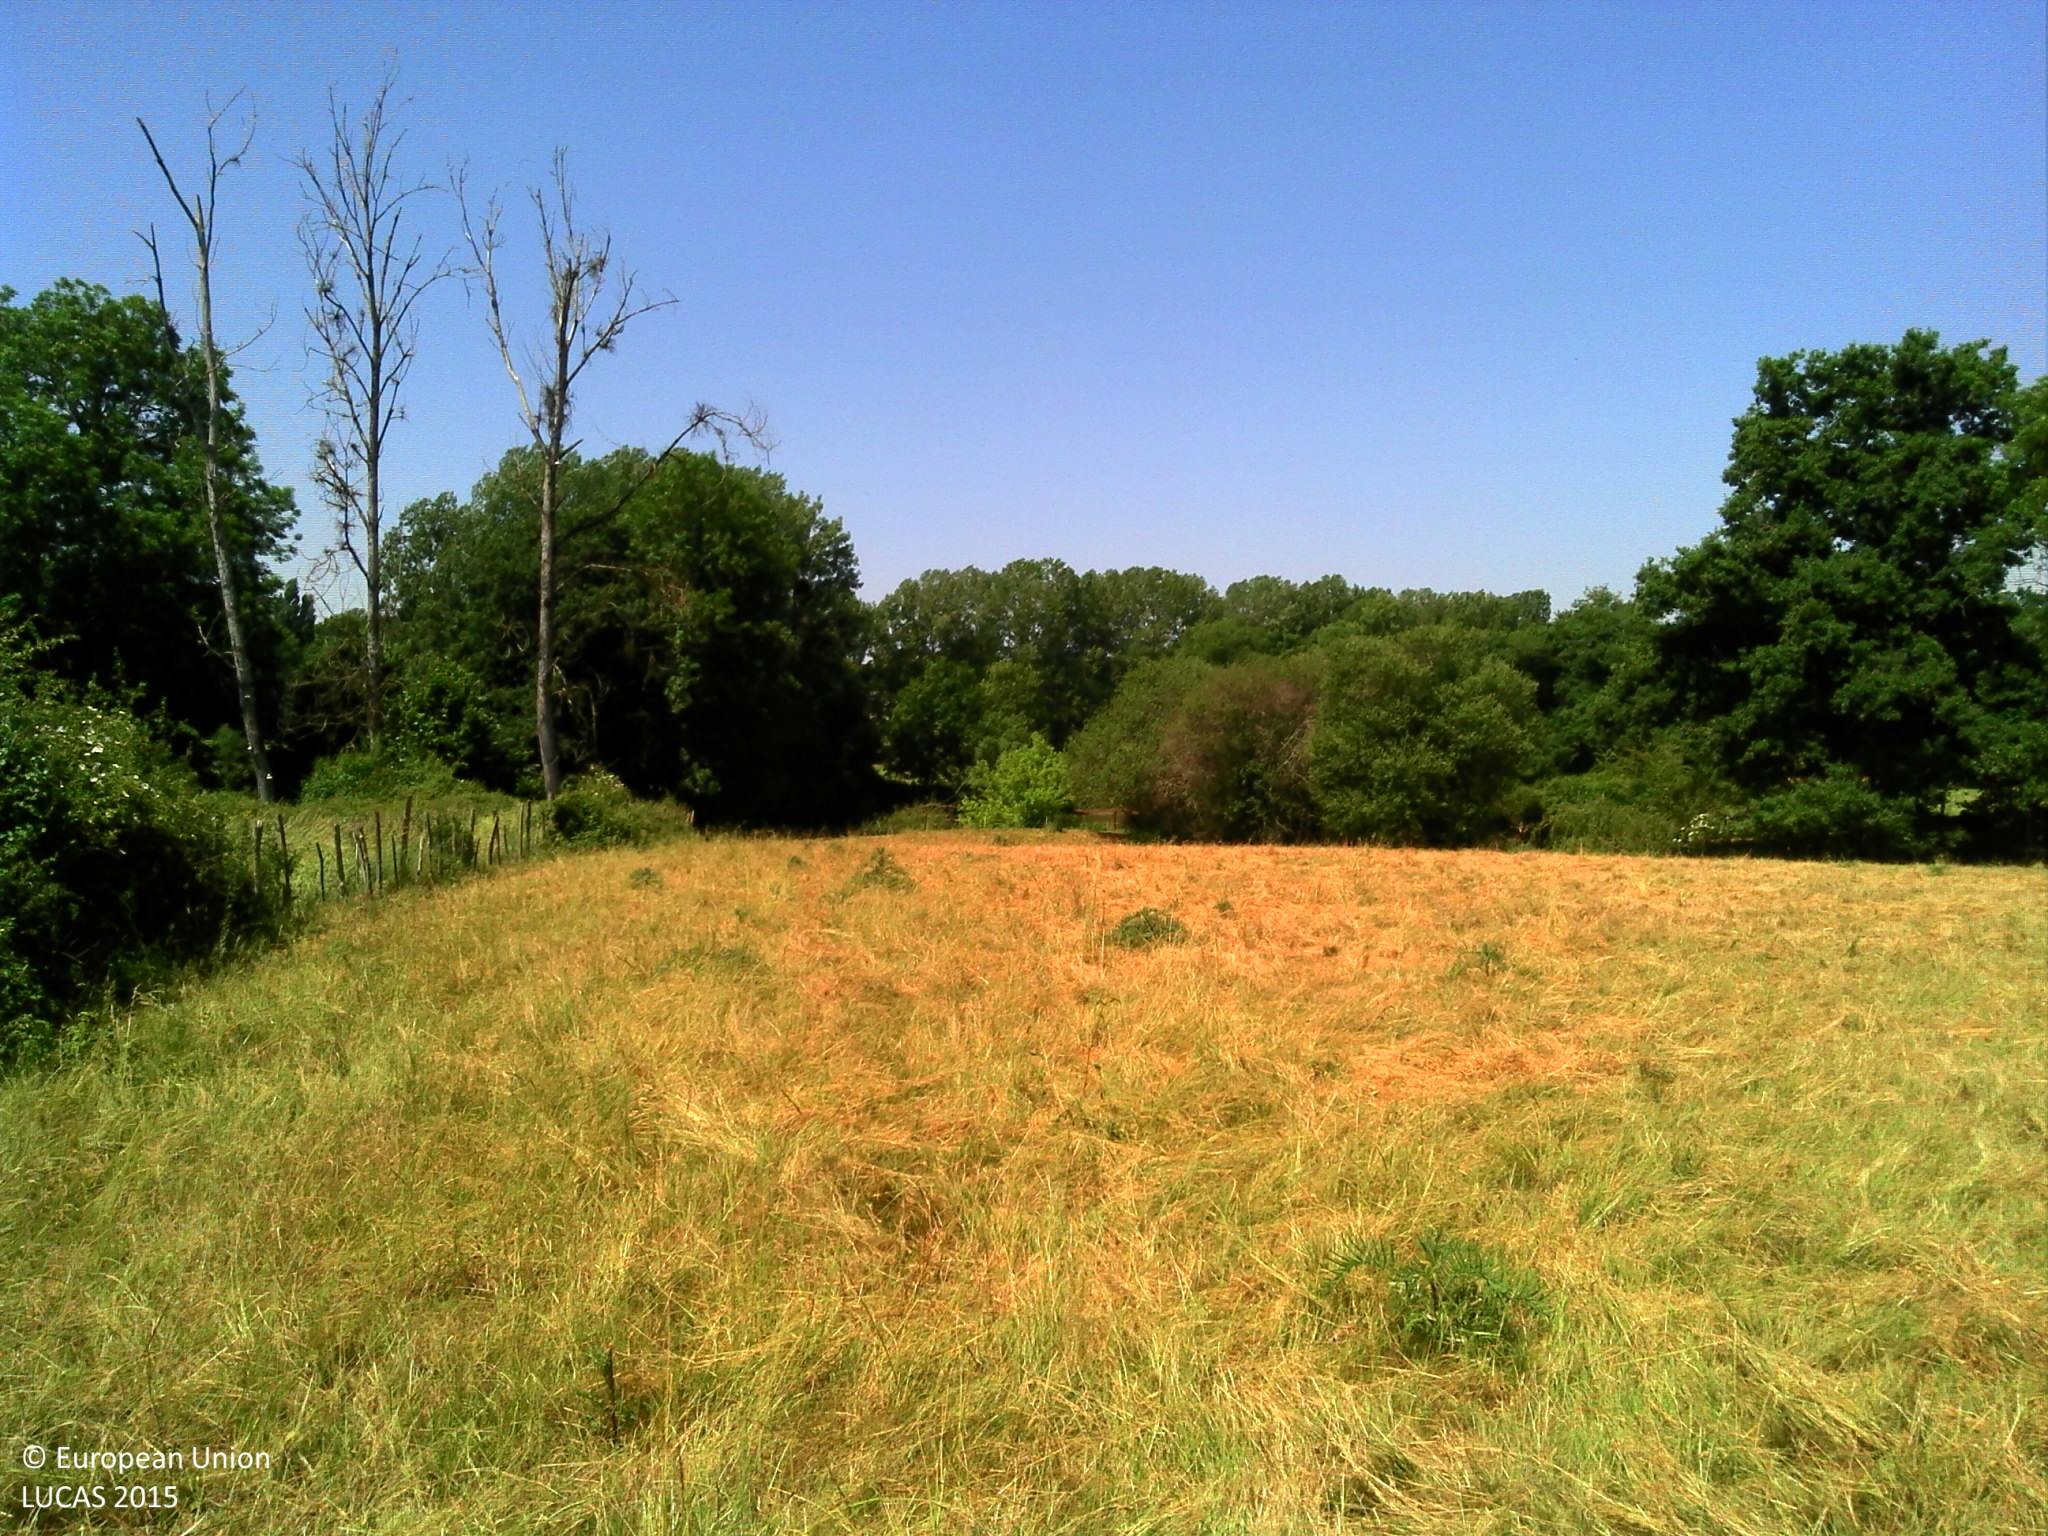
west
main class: Grassland
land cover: Grassland without tree/shrub cover
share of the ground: > 75 %
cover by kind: herbaceous plants 100 %
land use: Agriculture (excluding fallow land and kitchen gardens)
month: June
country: FR
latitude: 46.1070
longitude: 0.6837
